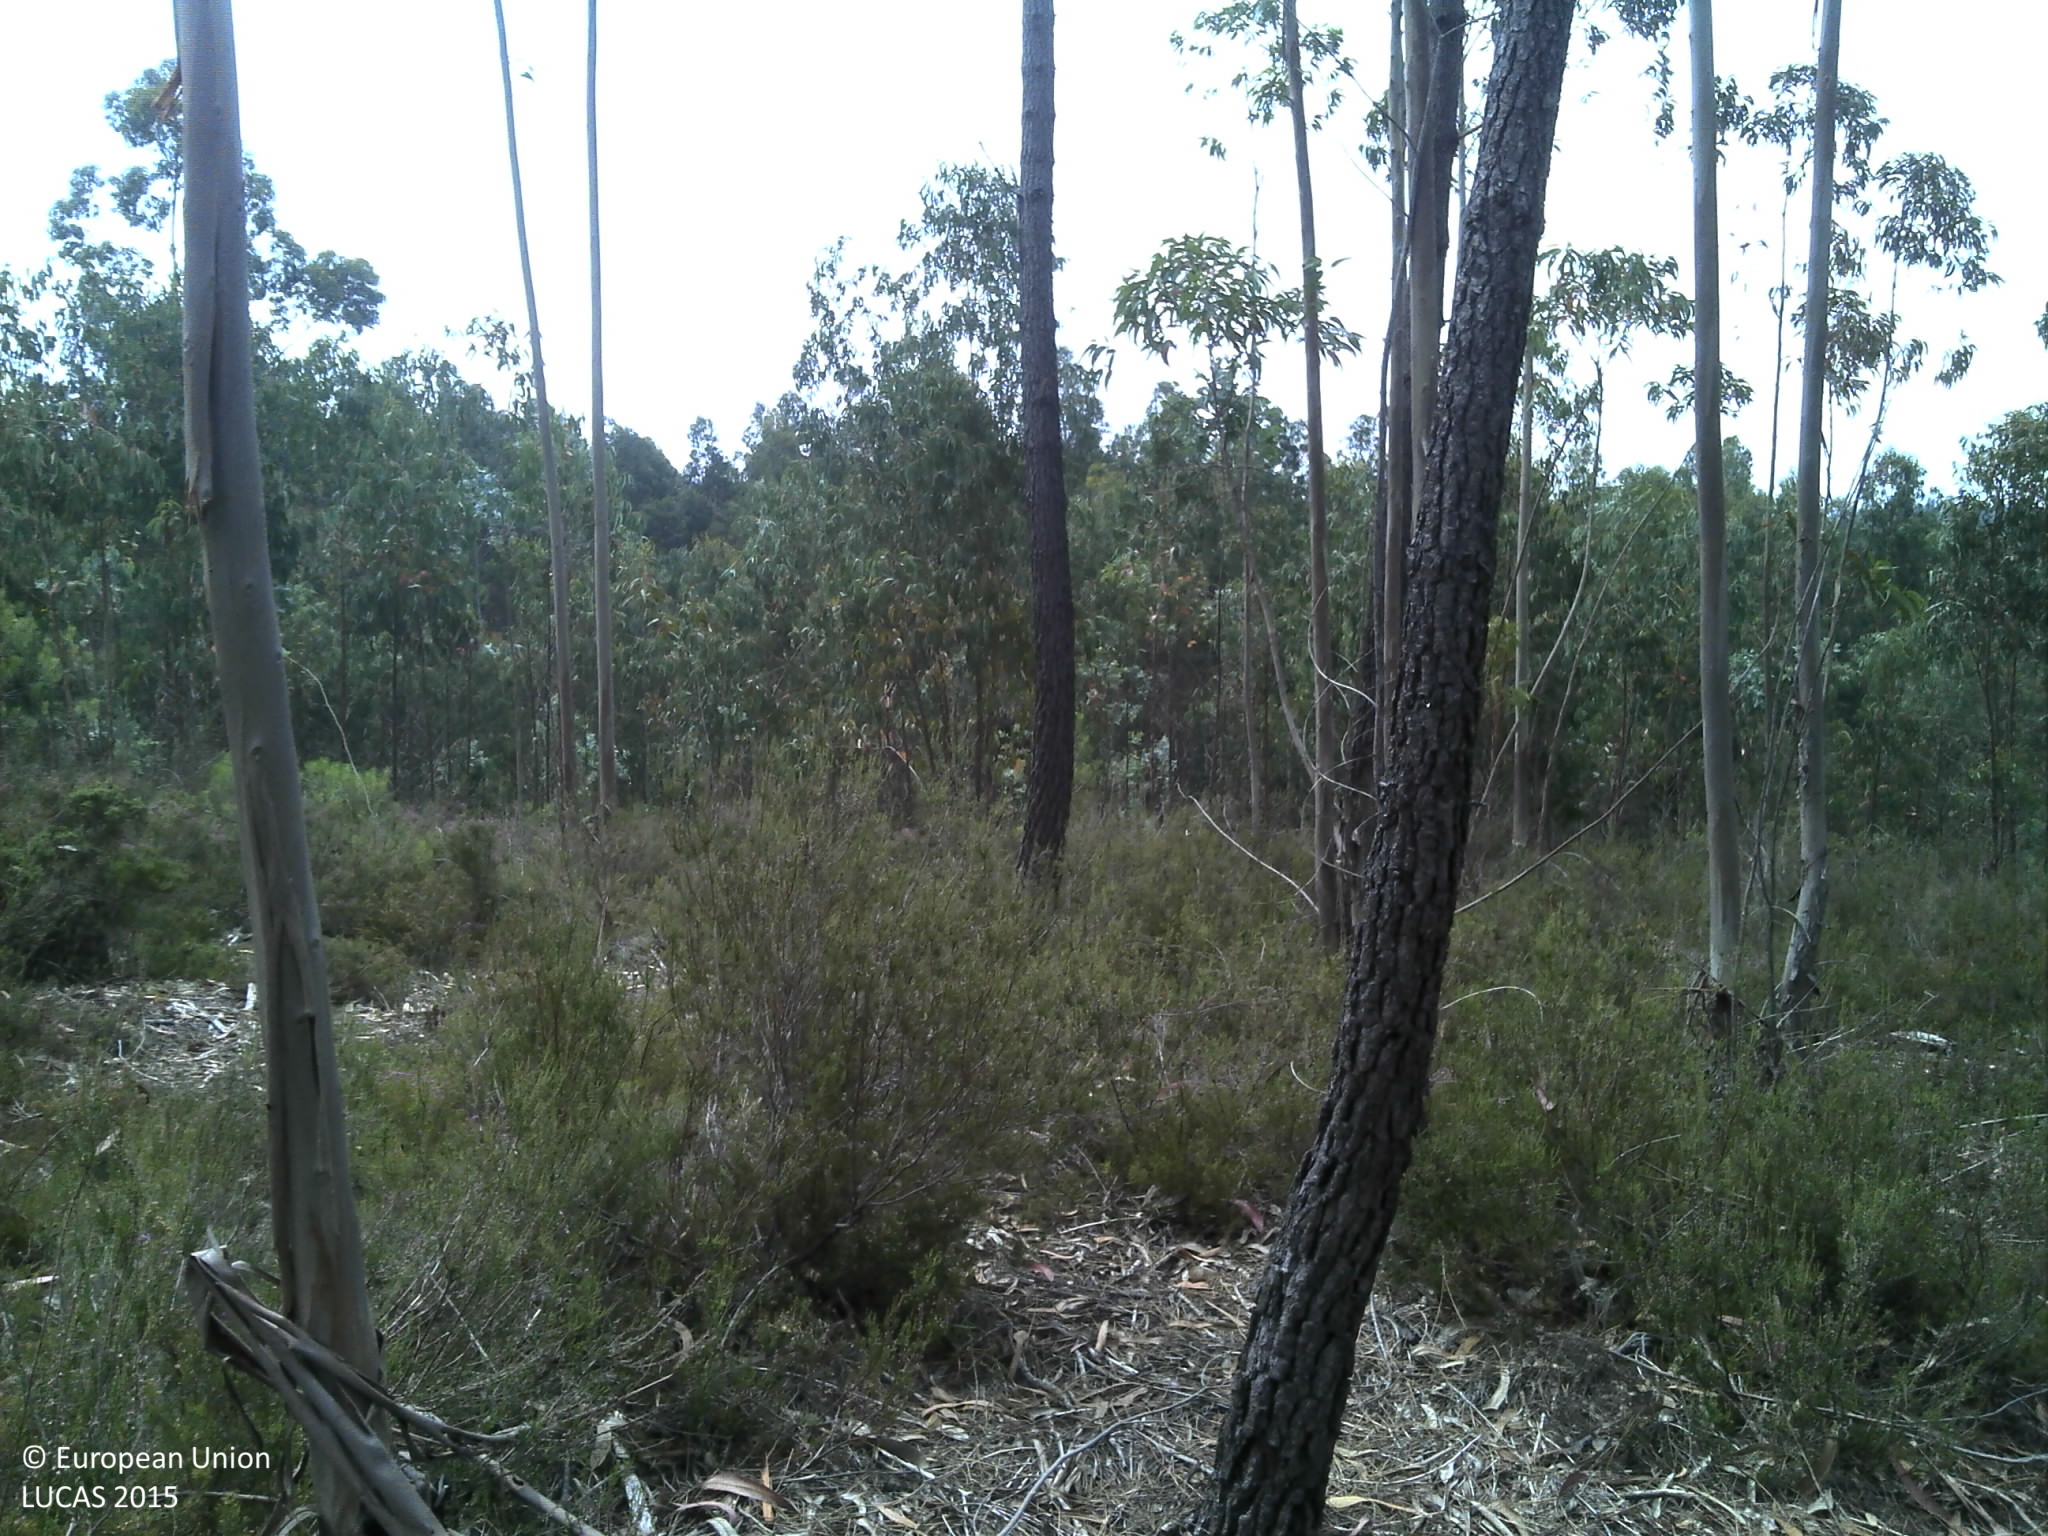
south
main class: Woodland
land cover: Pine dominated coniferous woodland
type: coniferous forest of the mediterranean region
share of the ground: 50 - 75 %
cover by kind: coniferous forest trees 60 %, shrubs 35 %, unconsolidated bare surface 5 %
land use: Forestry
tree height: > 5 m
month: June
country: PT
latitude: 40.4740
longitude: -8.3812
